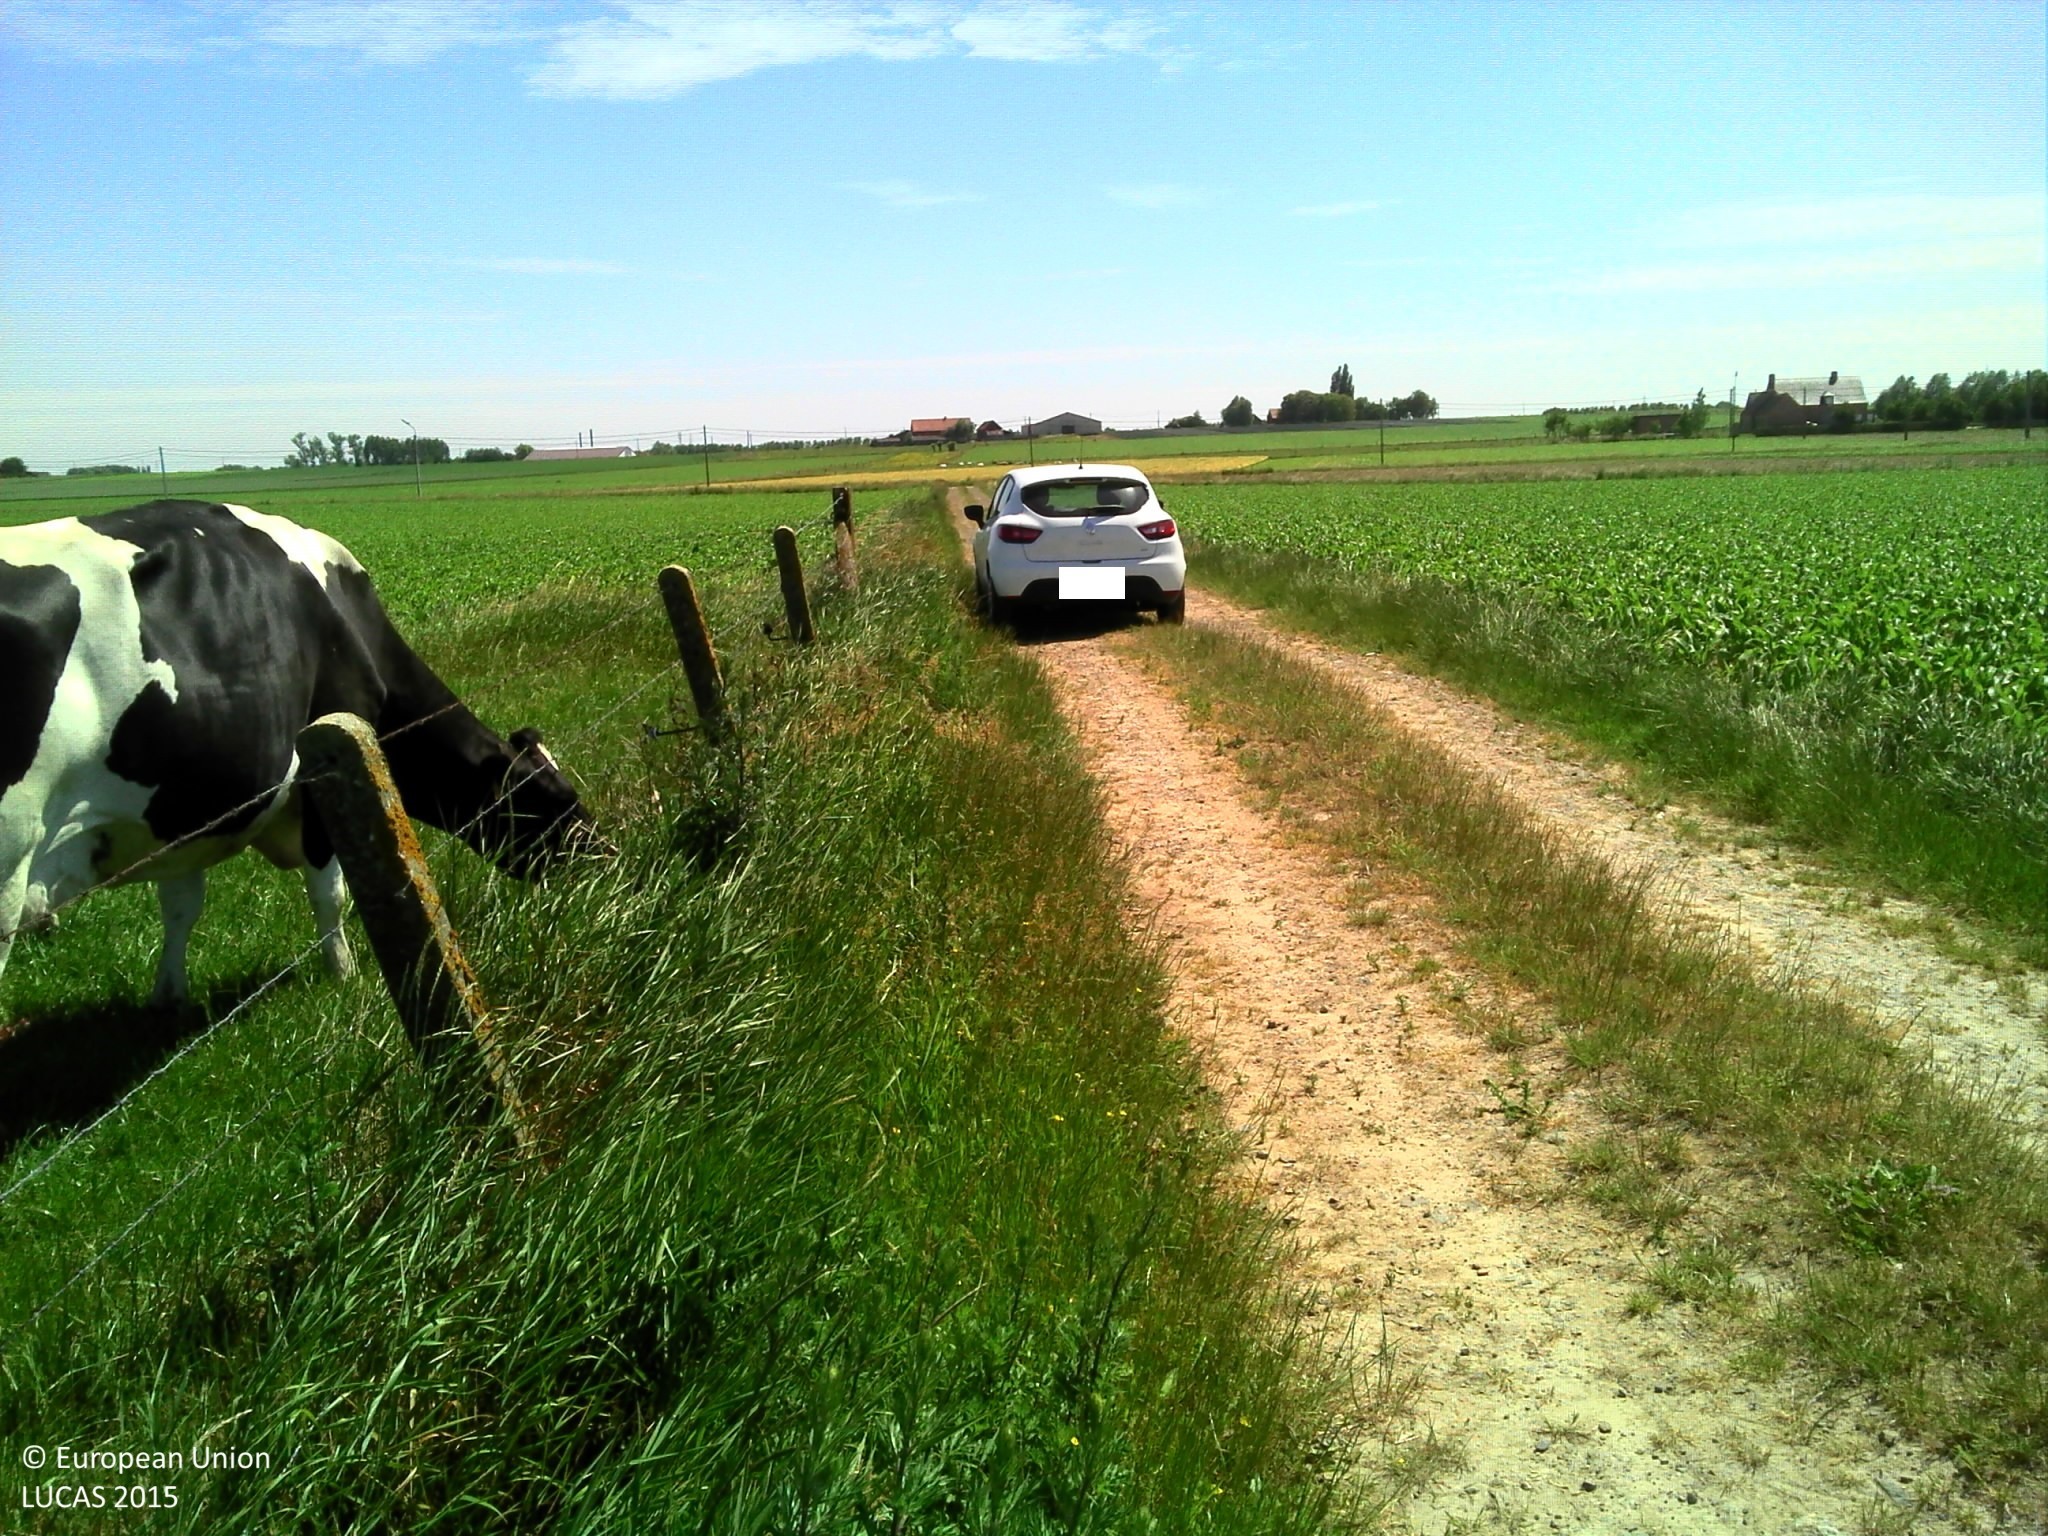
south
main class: Grassland
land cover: Grassland without tree/shrub cover
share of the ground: > 75 %
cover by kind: herbaceous plants 100 %
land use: Agriculture (excluding fallow land and kitchen gardens)
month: June
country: BE
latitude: 50.8867
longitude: 2.9532
